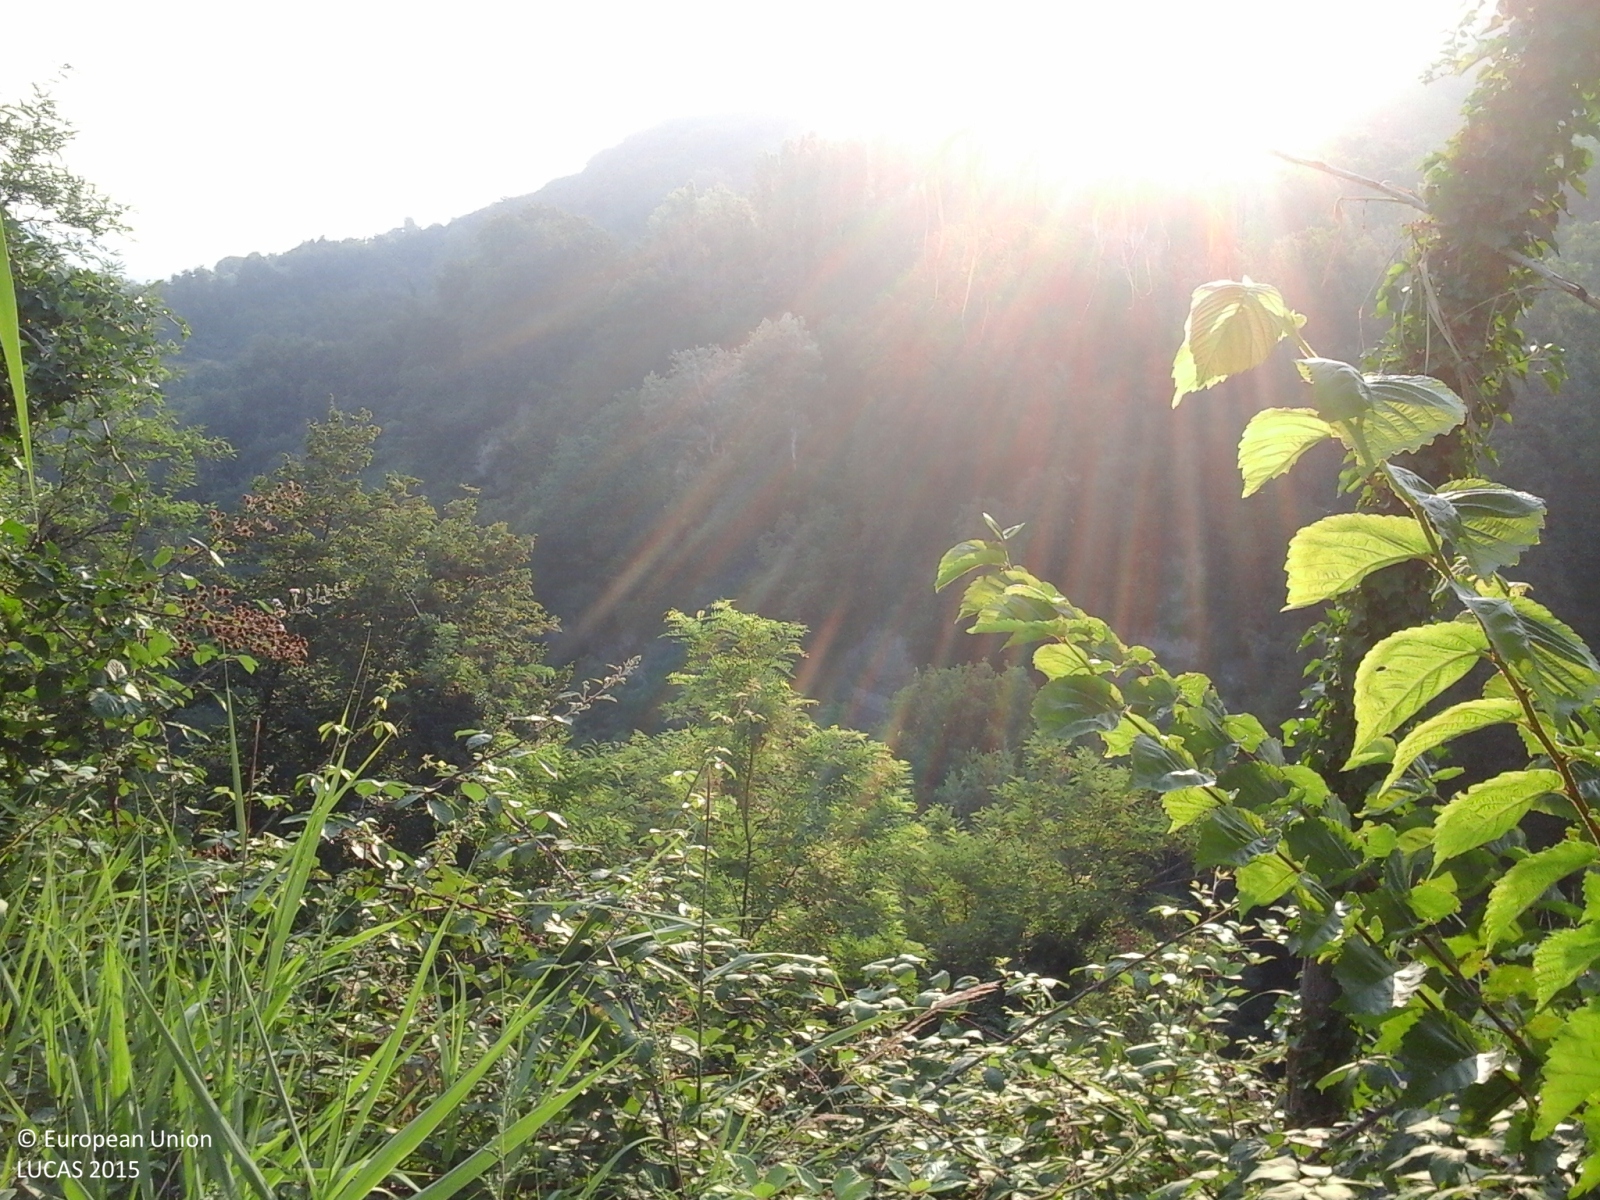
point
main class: Woodland
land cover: Broadleaved woodland
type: thermophilous deciduous forest
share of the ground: > 75 %
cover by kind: broadleaved forest trees 100 %
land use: Semi-natural and natural areas not in use
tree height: > 5 m
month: July
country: IT
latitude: 44.0740
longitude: 12.2299
